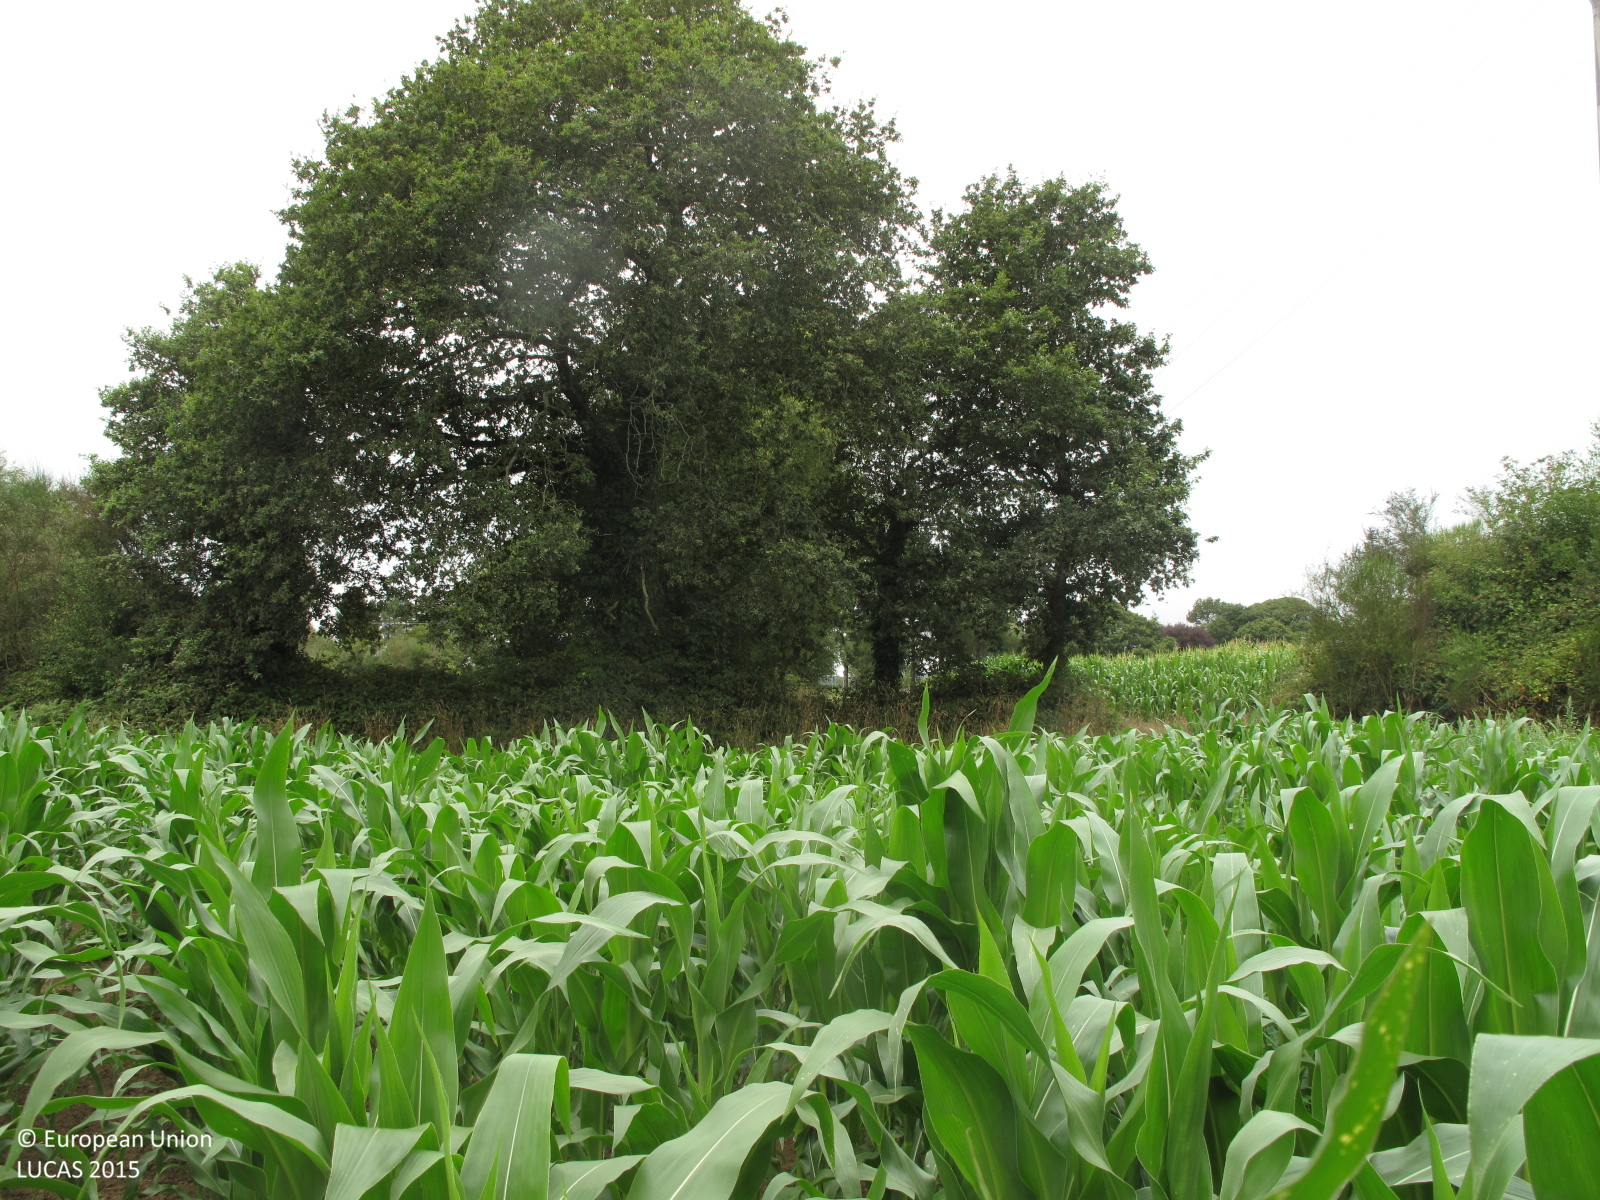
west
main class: Cropland
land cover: Maize
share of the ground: > 75 %
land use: Agriculture (excluding fallow land and kitchen gardens)
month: July
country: ES
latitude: 43.1380
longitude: -8.0552
